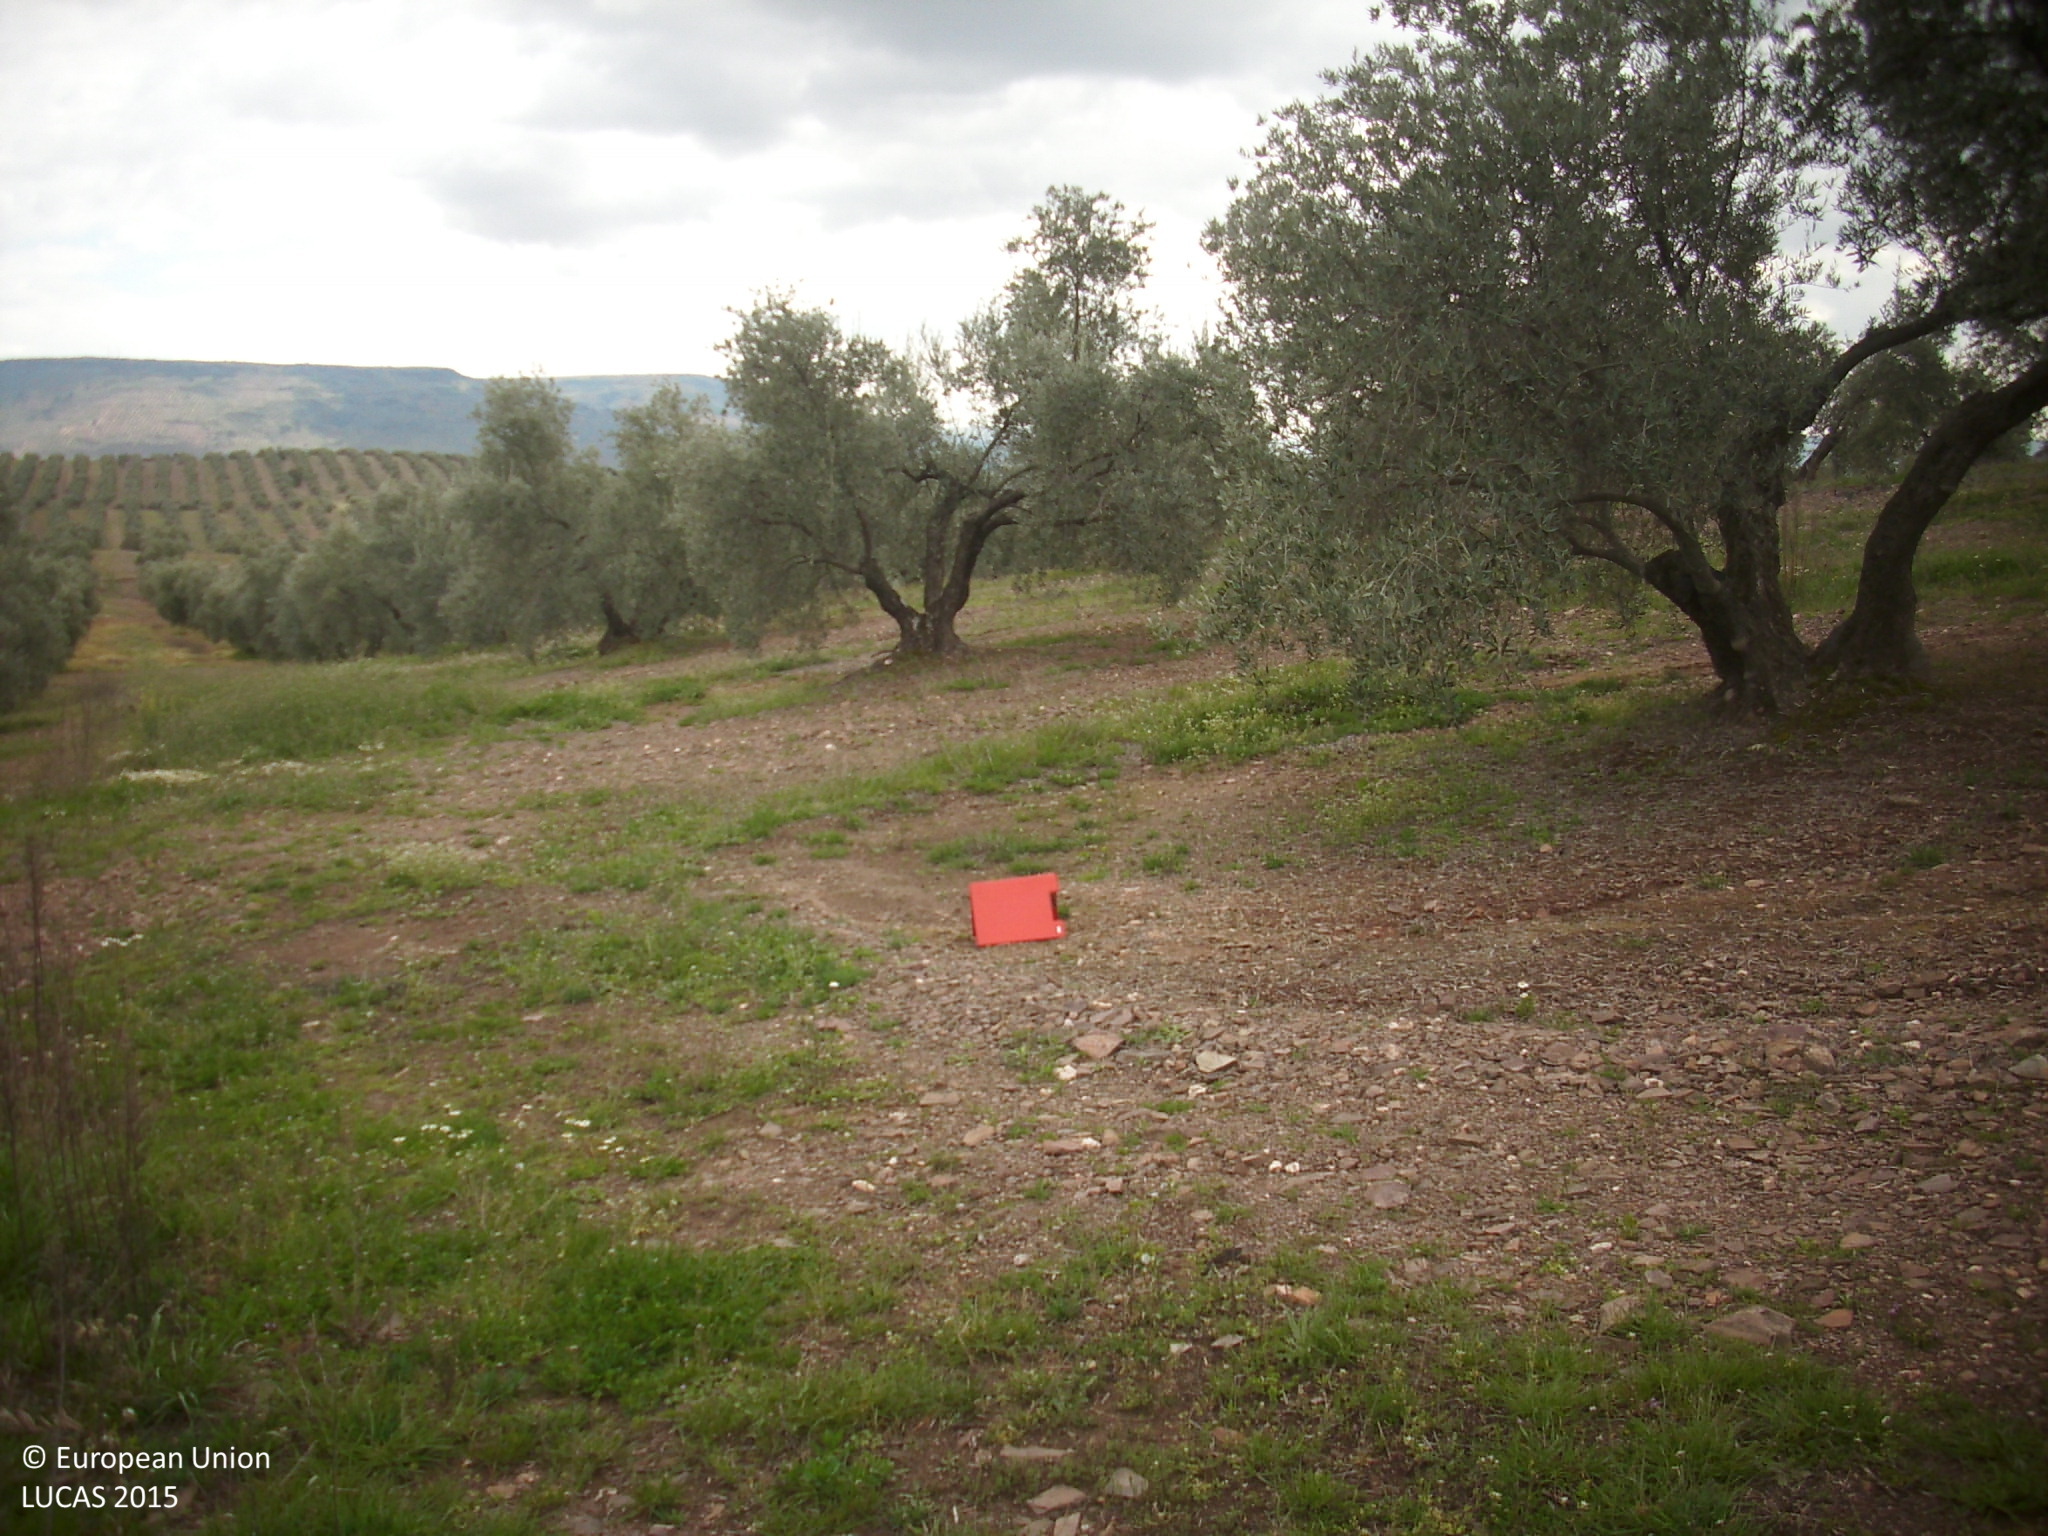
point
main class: Cropland
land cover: Olive groves
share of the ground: 25 - 50 %
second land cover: Spontaneously vegetated surfaces
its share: > 75 %
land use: Agriculture (excluding fallow land and kitchen gardens)
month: March
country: ES
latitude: 38.3552
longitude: -3.1283
